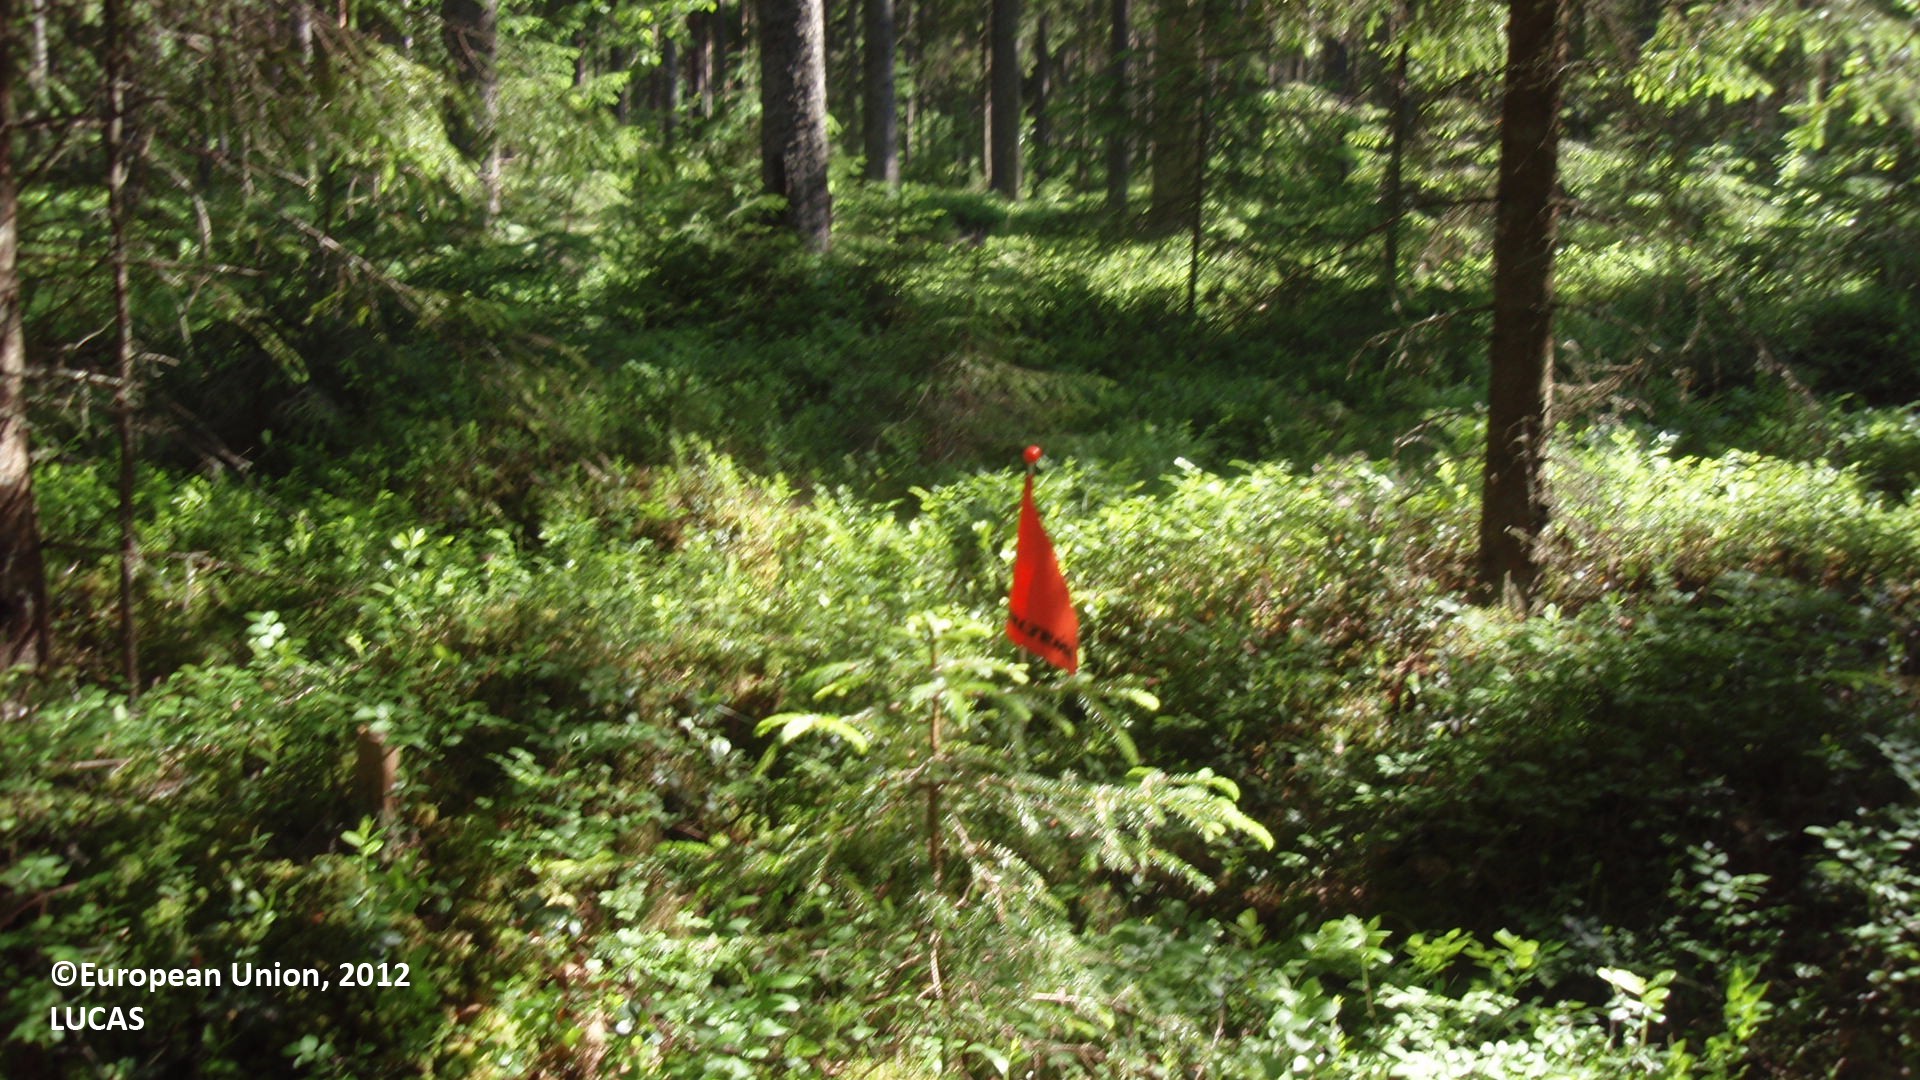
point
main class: Woodland
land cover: Spruce dominated mixed woodland
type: boreal forest
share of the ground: > 75 %
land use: Forestry
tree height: > 5 m
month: June
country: FI
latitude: 61.7416
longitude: 27.0305
